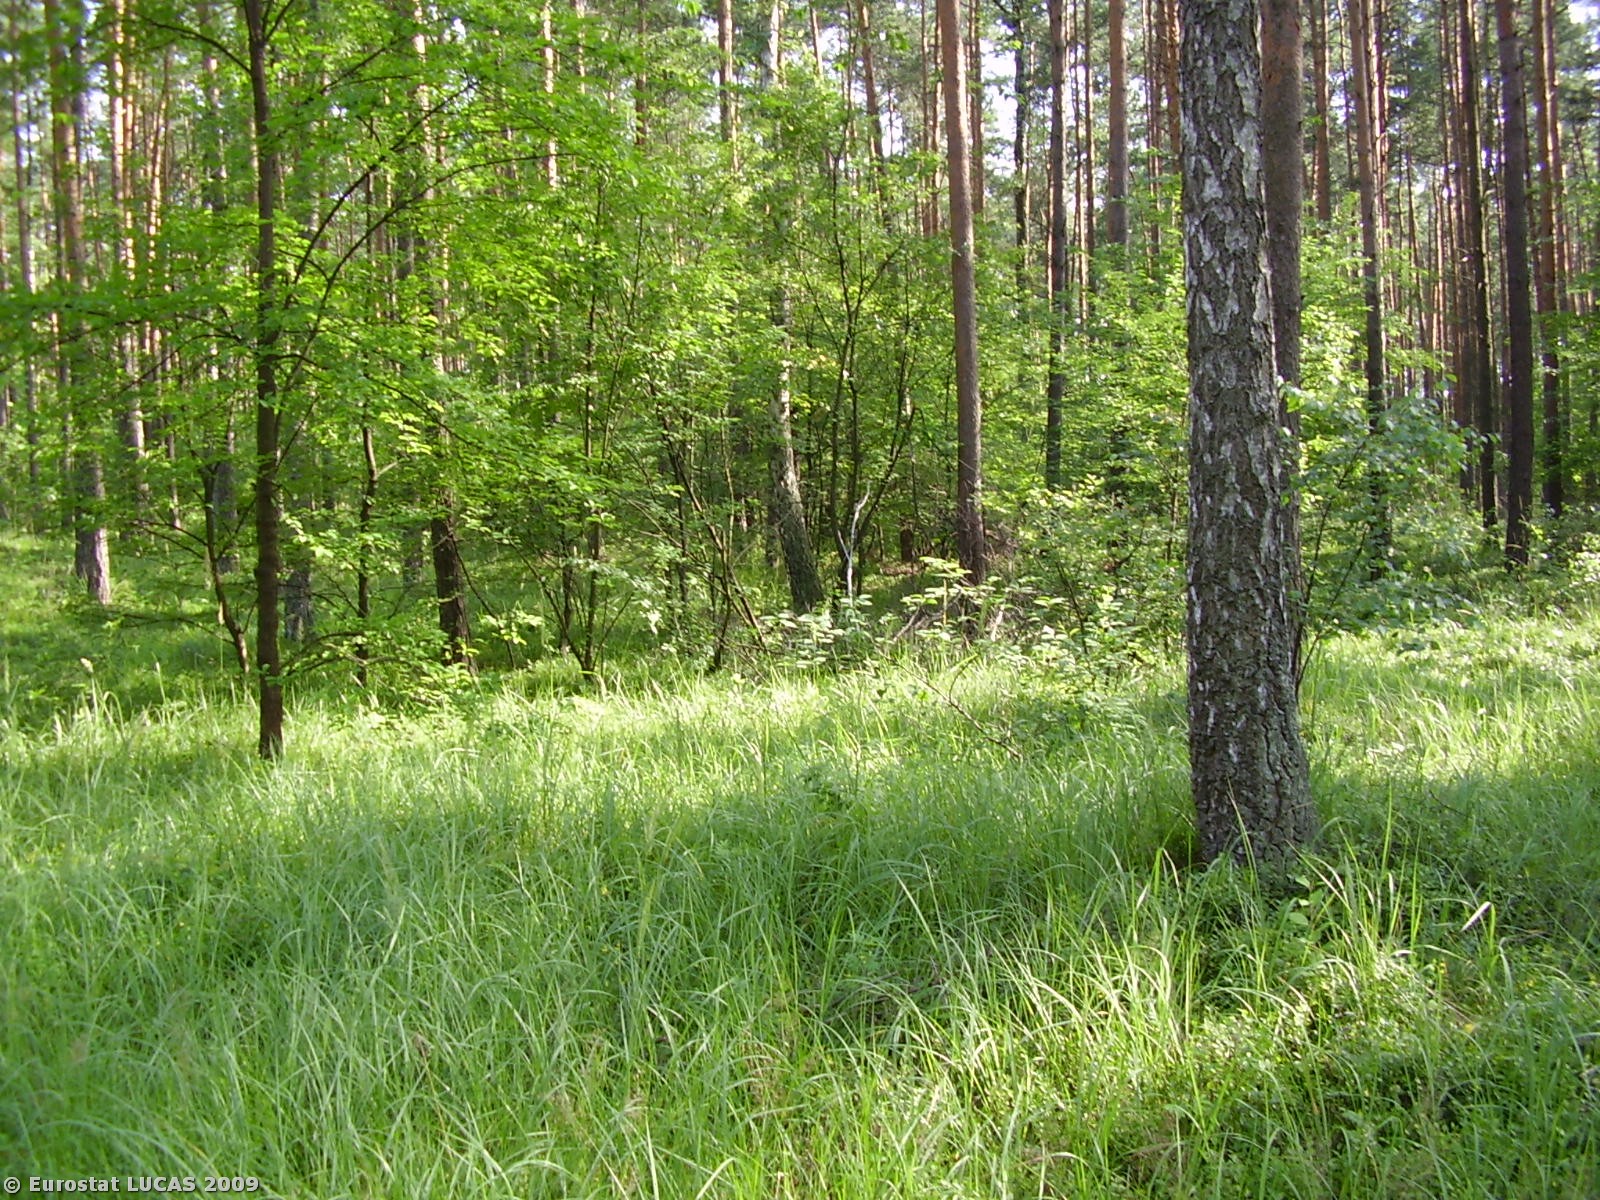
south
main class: Woodland
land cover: Mixed woodland
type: hemiboreal forest and nemoral coniferous forest and mixed broadleaved-coniferous forest
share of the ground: > 75 %
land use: Forestry
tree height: > 5 m
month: July
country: PL
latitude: 51.3336
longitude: 17.9529
